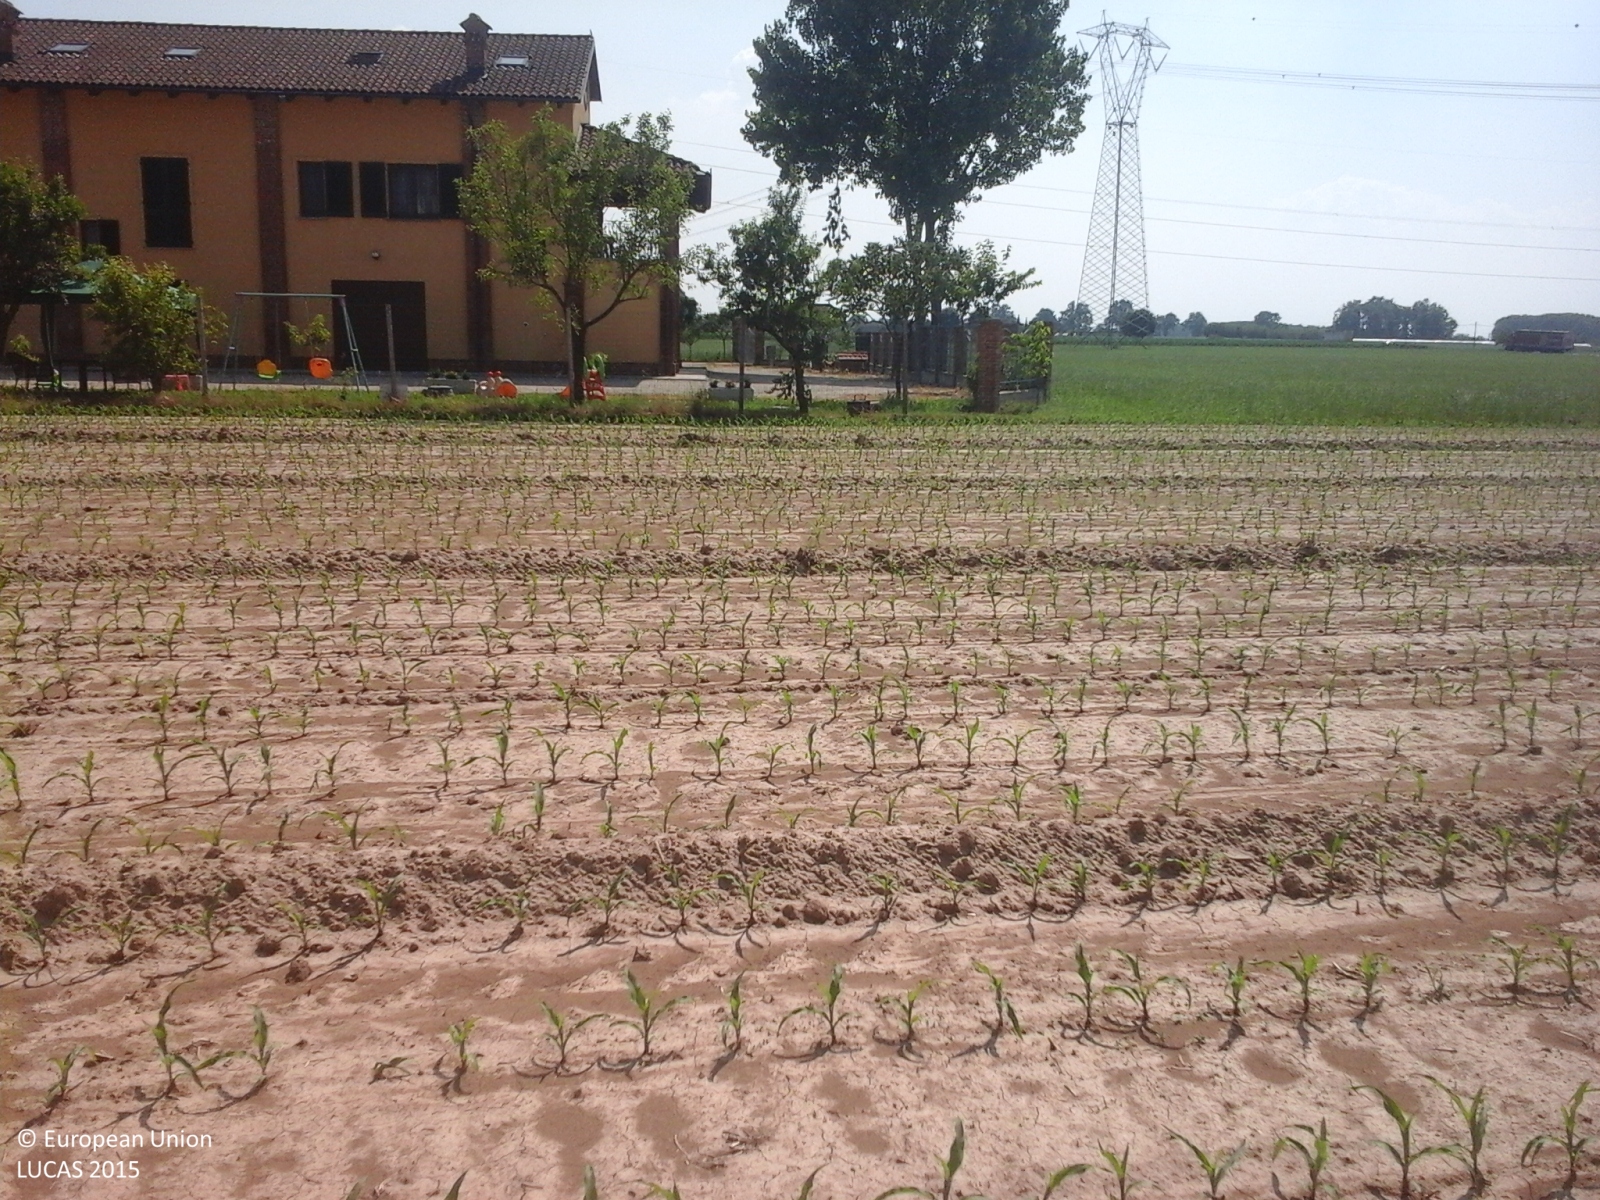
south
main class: Cropland
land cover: Maize
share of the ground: < 10 %
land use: Agriculture (excluding fallow land and kitchen gardens)
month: June
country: IT
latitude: 44.8682
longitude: 7.7892
